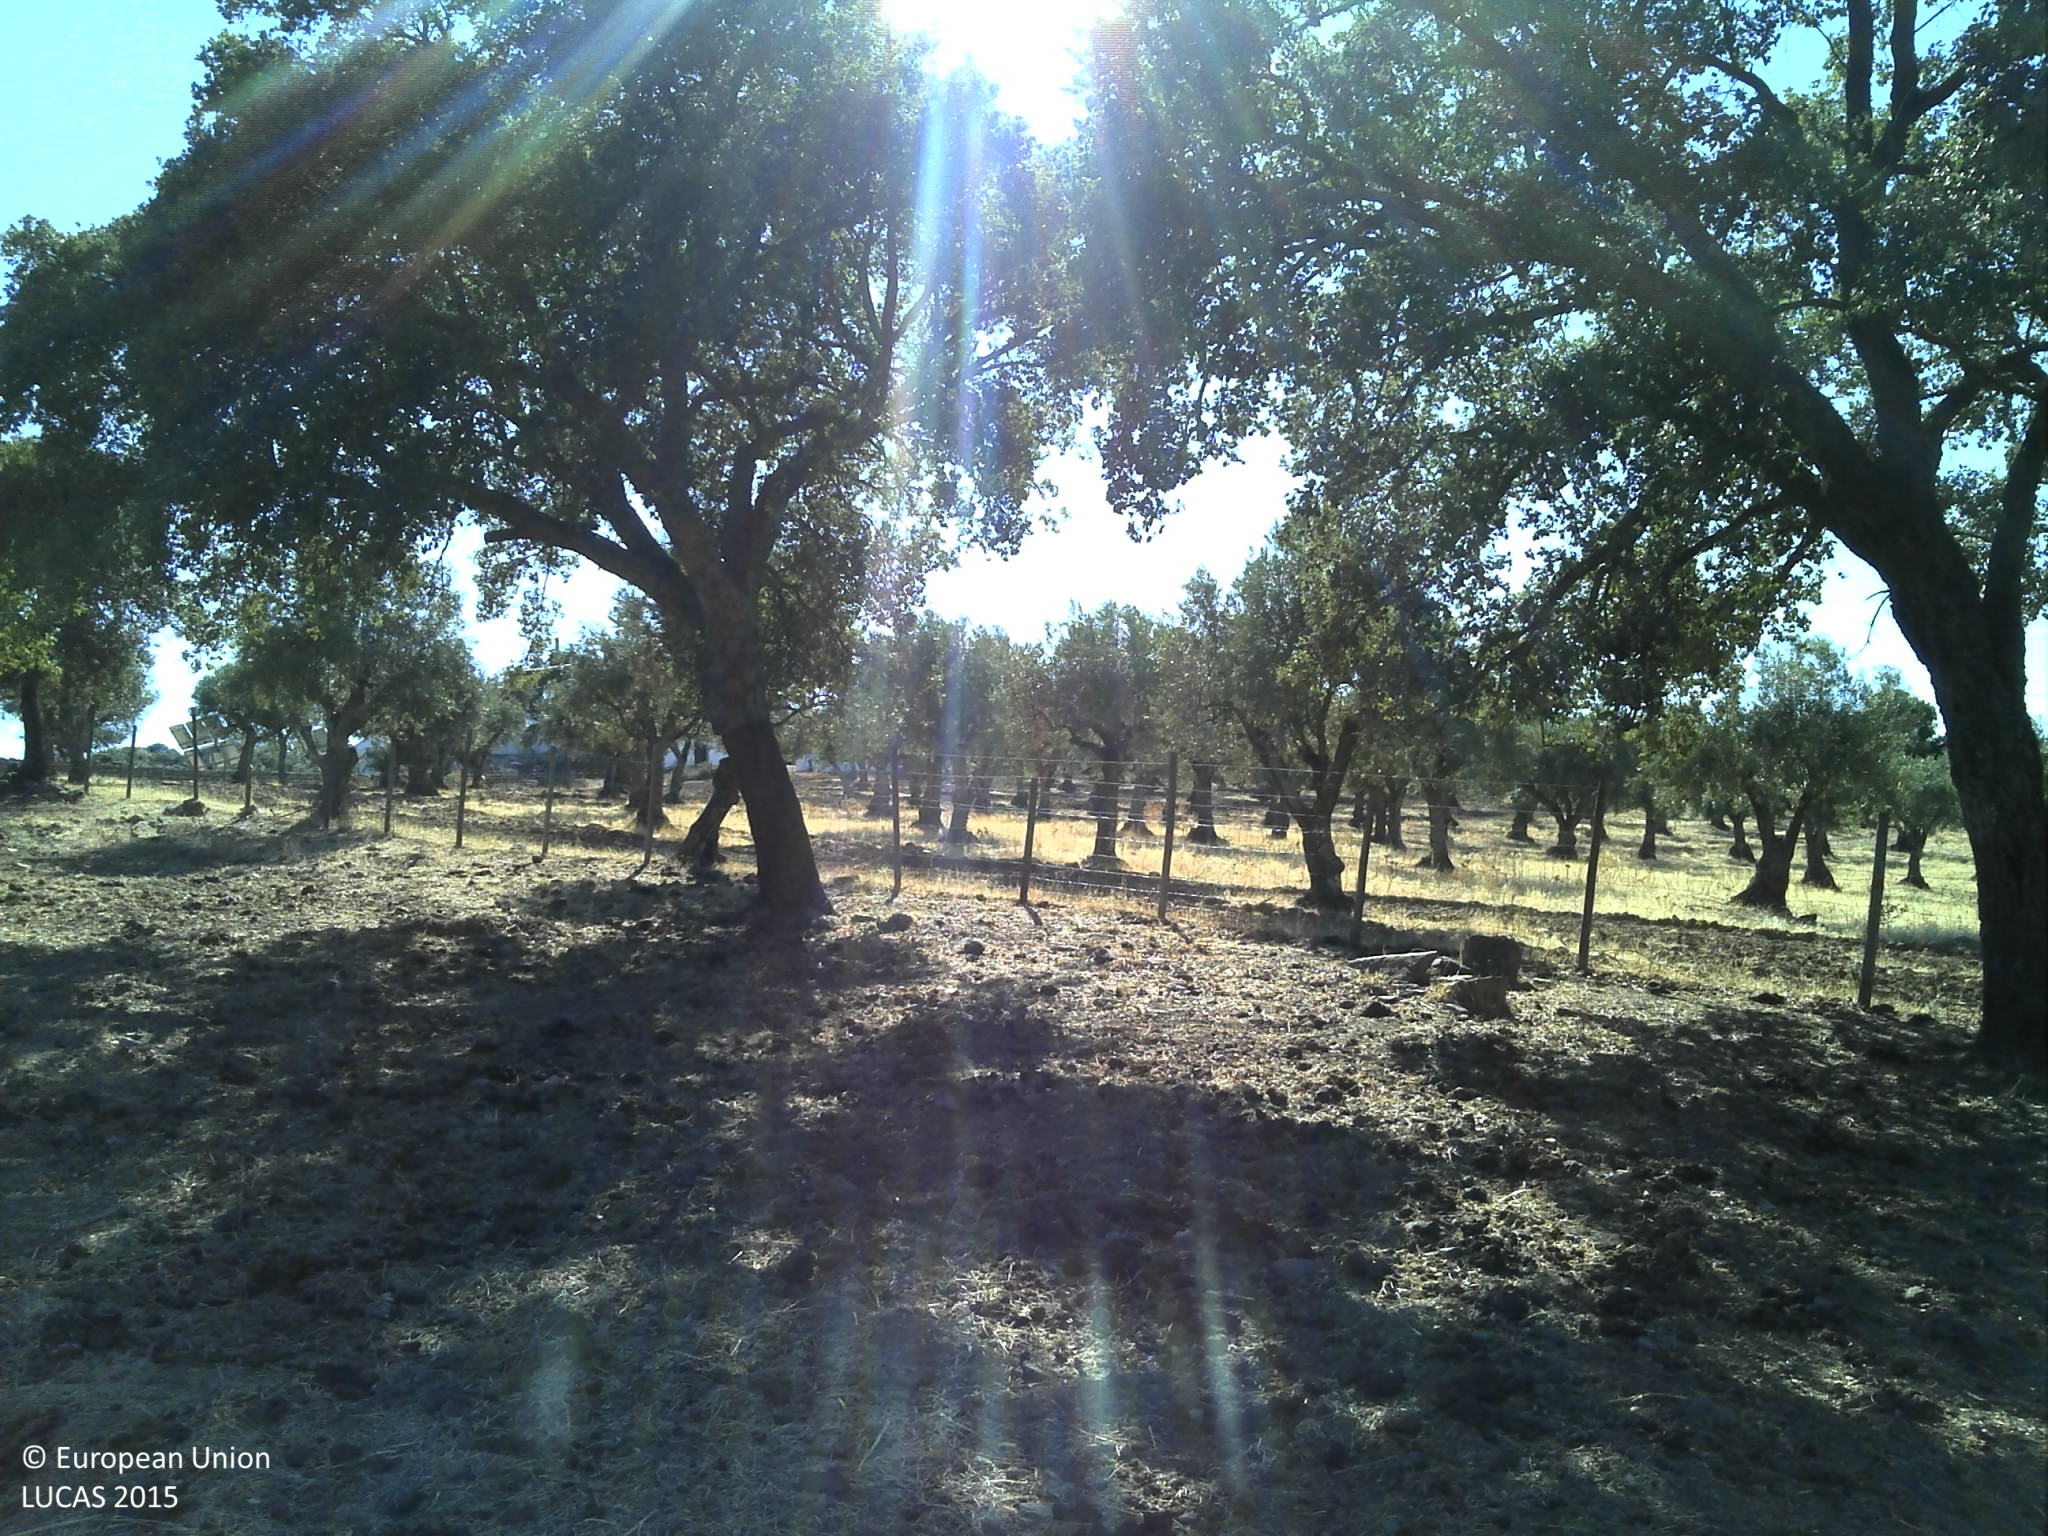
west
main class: Woodland
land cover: Broadleaved woodland
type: broadleaved evergreen forest
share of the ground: 10 - 25 %
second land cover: Grassland without tree/shrub cover
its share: 10 - 25 %
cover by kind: unconsolidated bare surface 75 %, herbaceous plants 15 %, broadleaved forest trees 10 %
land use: Forestry
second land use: Agriculture (excluding fallow land and kitchen gardens)
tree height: > 5 m
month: August
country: PT
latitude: 39.5198
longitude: -7.5550
